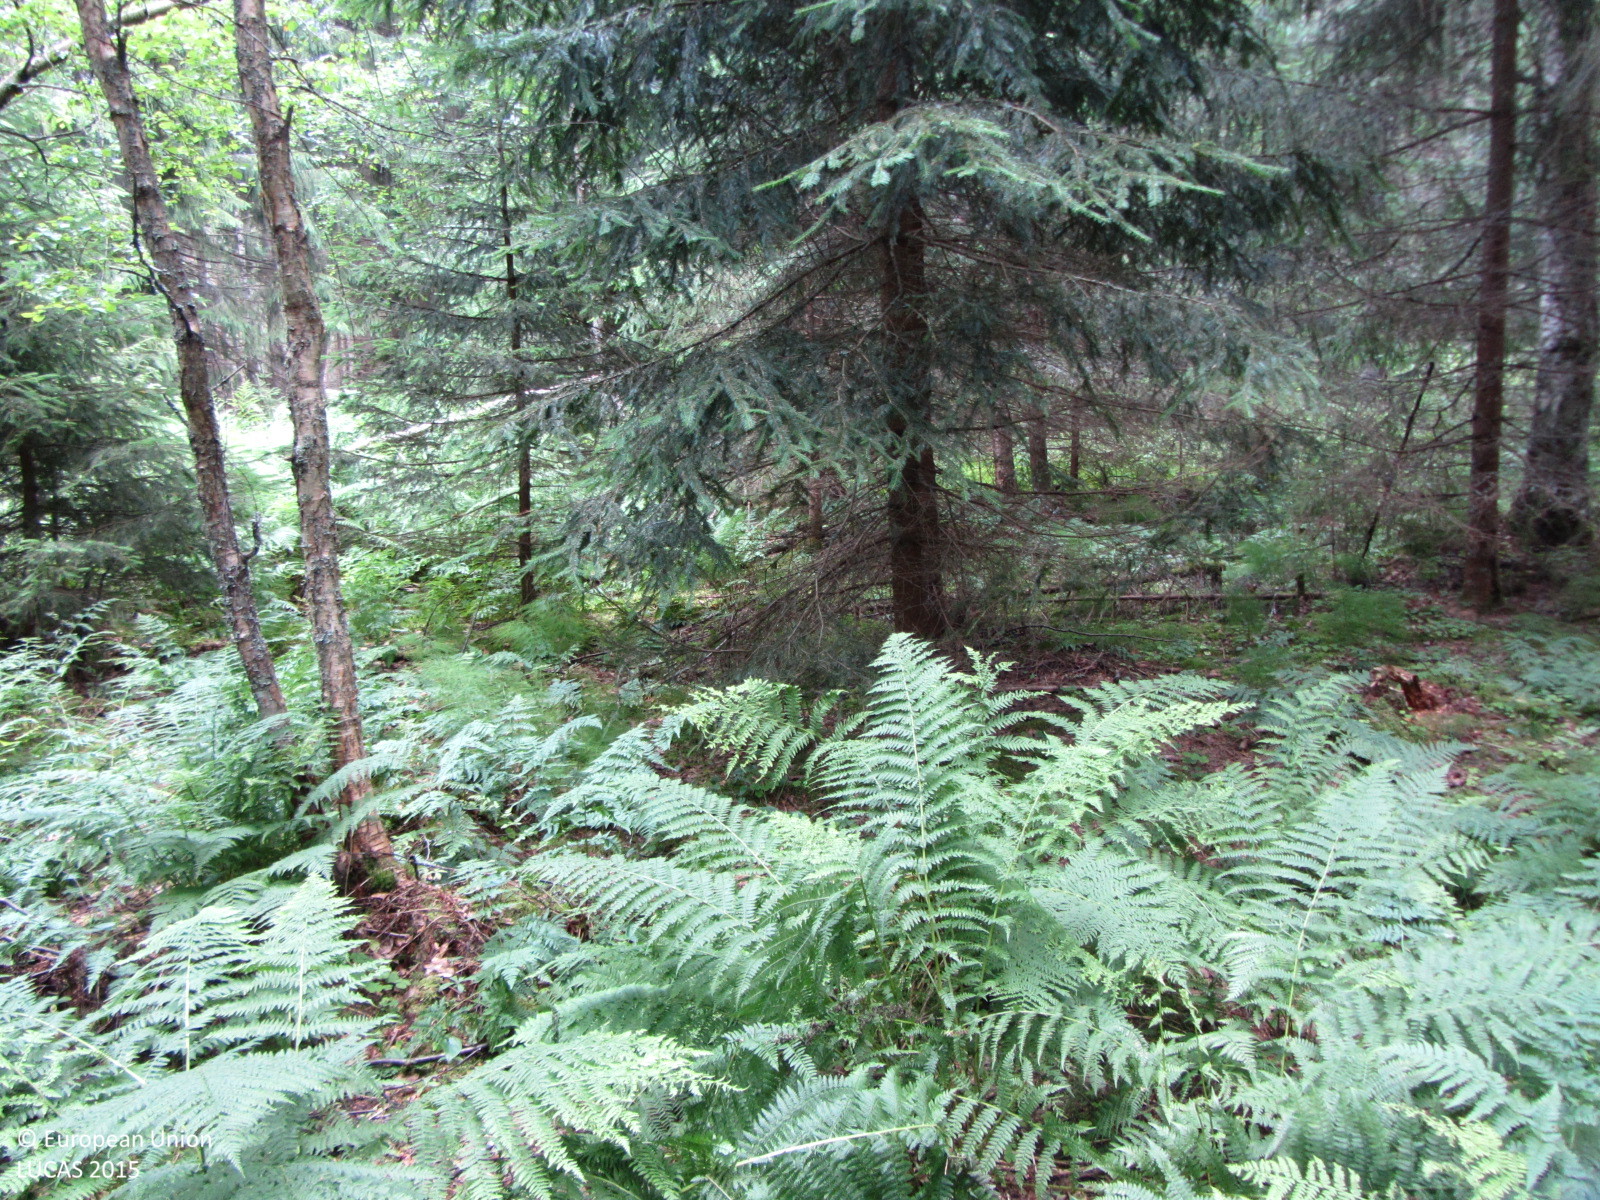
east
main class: Woodland
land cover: Spruce dominated mixed woodland
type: boreal forest
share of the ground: > 75 %
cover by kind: coniferous forest trees 45 %, broadleaved forest trees 40 %, herbaceous plants 15 %
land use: Forestry
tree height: > 5 m
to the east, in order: Spruce dominated mixed woodland; Ditches and canals; Spruce dominated mixed woodland; Ditches and canals; Spruce dominated mixed woodland; Ditches and canals; Other mixed woodland
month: July
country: FI
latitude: 60.0652
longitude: 24.1695
